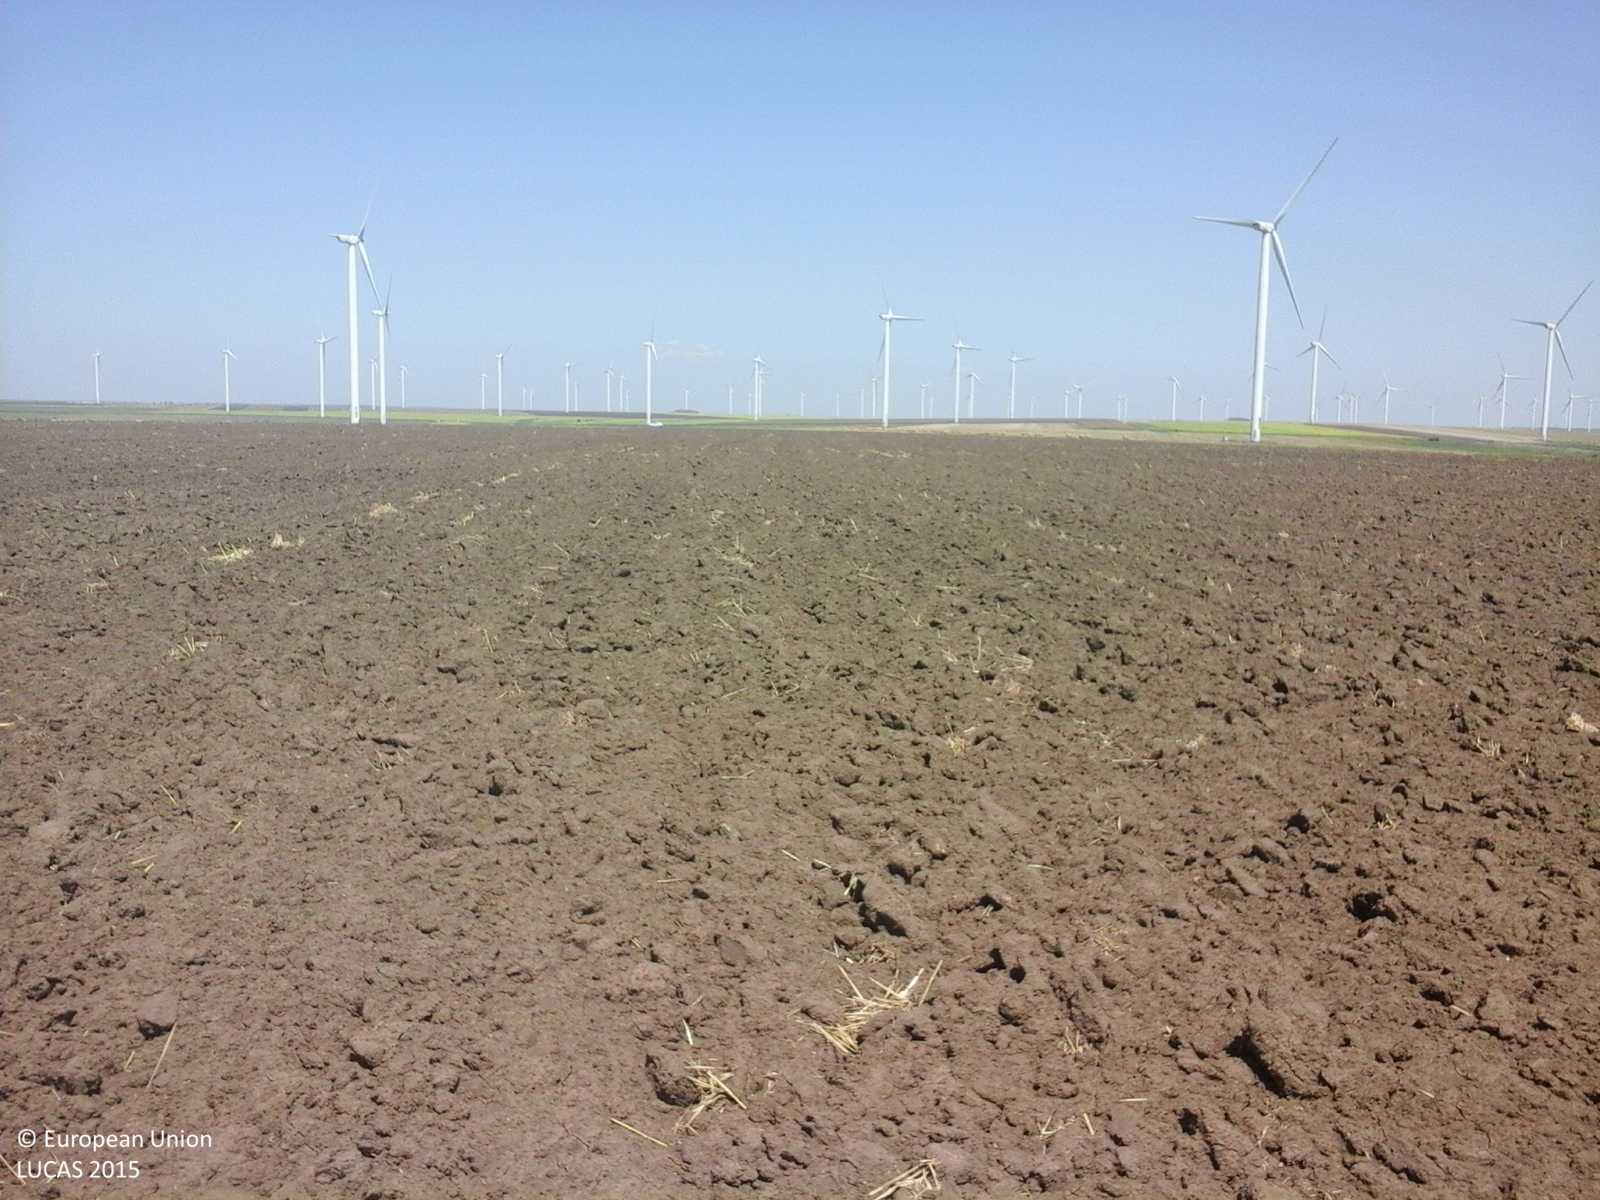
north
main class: Cropland
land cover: Common wheat
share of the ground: < 10 %
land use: Agriculture (excluding fallow land and kitchen gardens)
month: August
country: RO
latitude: 44.6022
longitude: 28.5328
